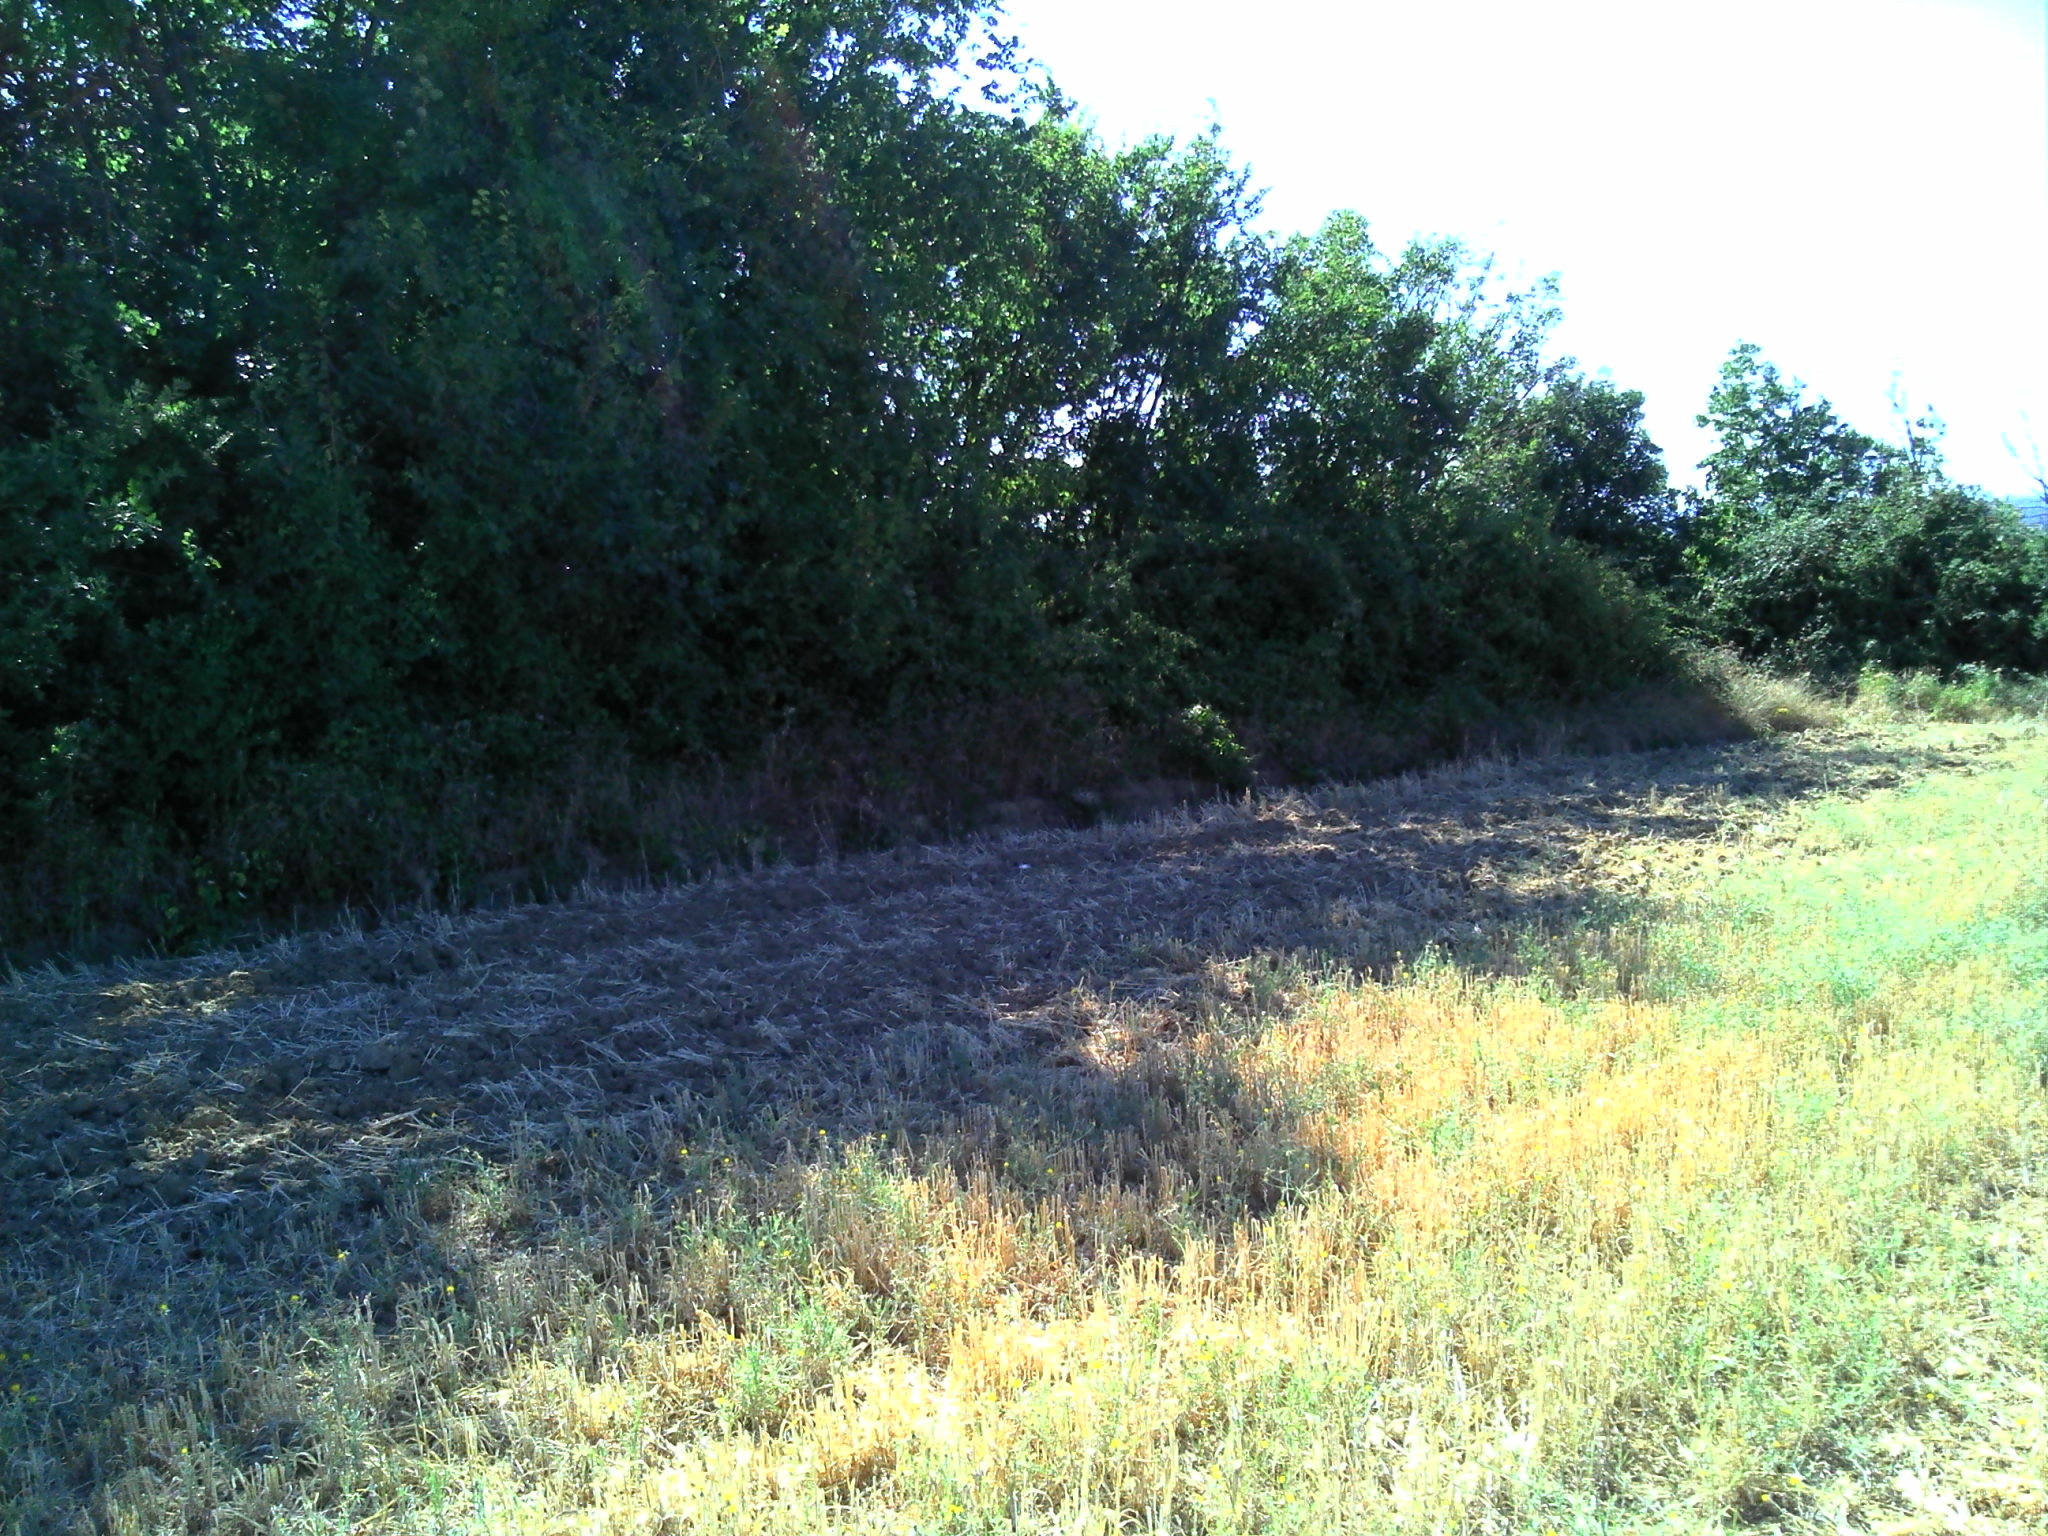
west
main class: Cropland
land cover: Barley
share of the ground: 10 - 25 %
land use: Agriculture (excluding fallow land and kitchen gardens)
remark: Harvested field
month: July
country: FR
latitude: 43.9623
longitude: 4.3626
